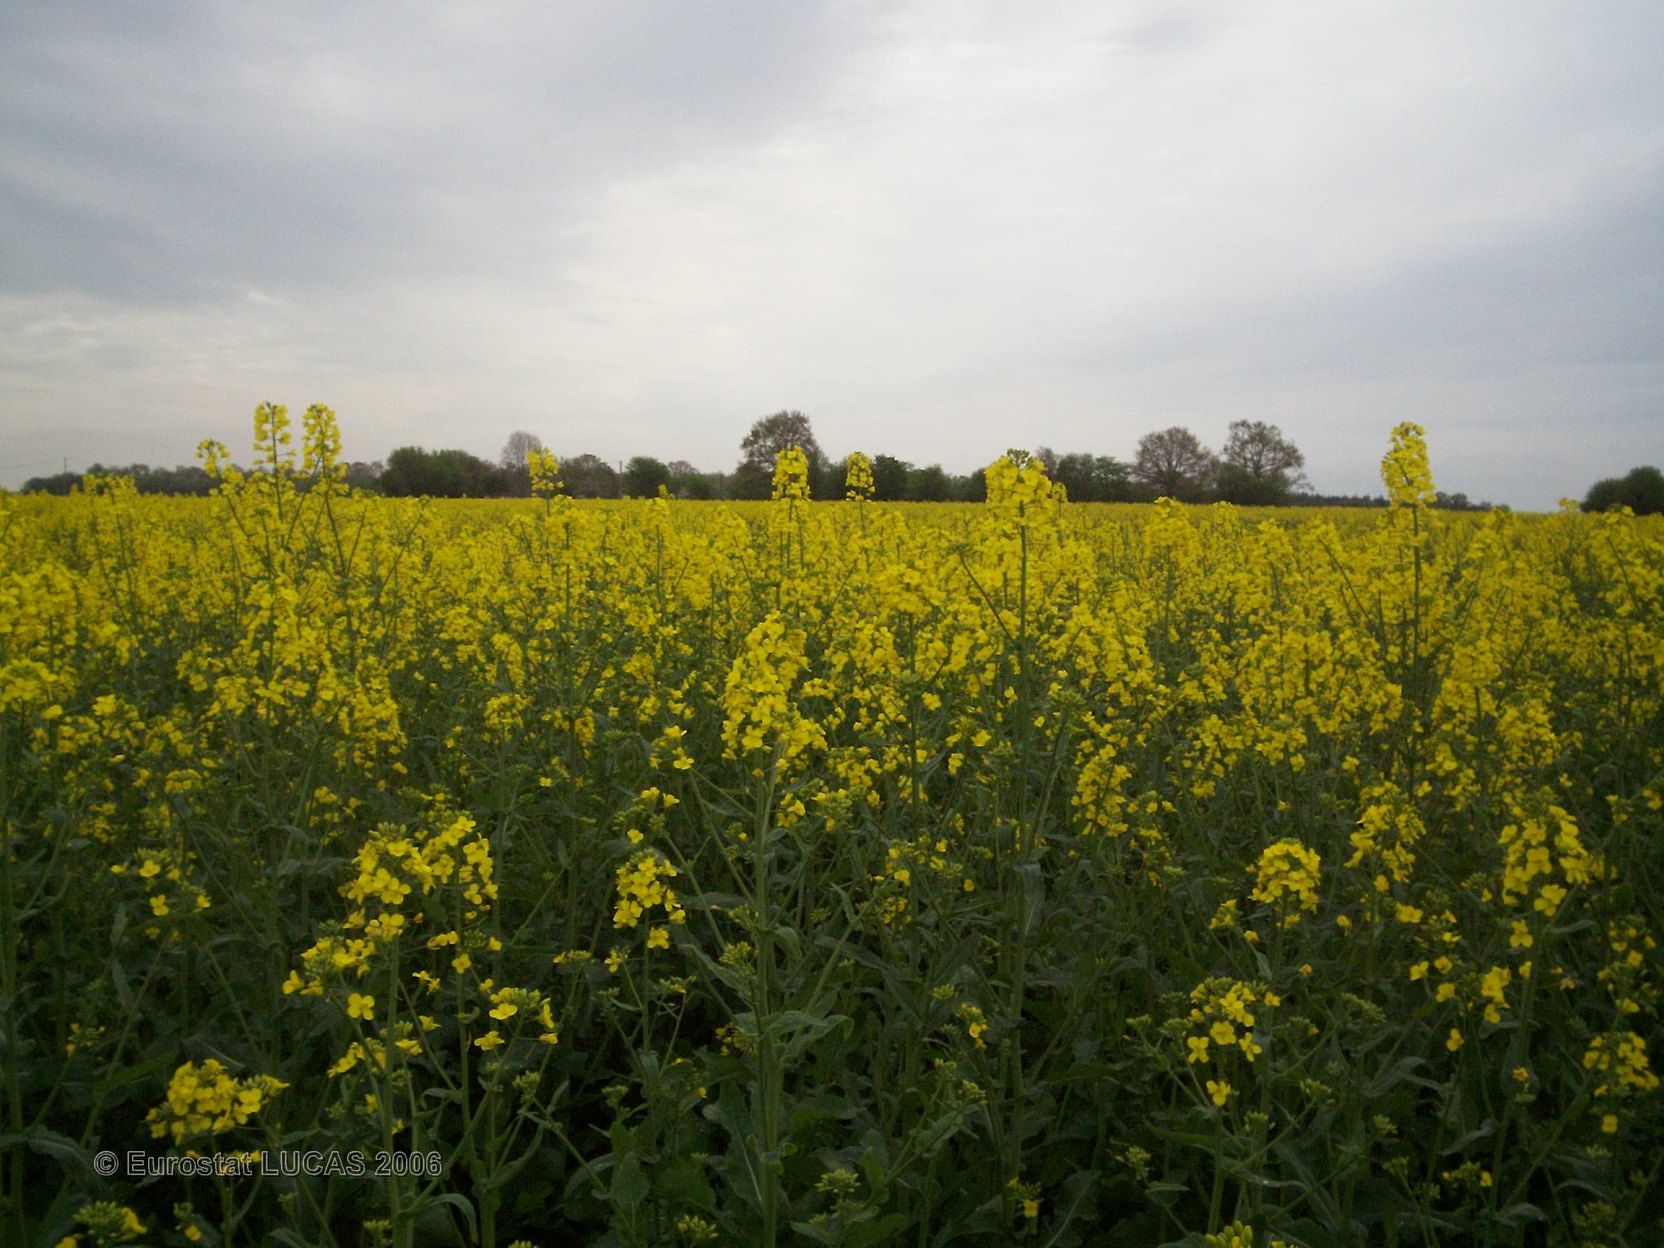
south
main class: Cropland
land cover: Rape and turnip rape
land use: Agriculture (excluding fallow land and kitchen gardens)
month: May
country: FR
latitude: 48.8724
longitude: 0.6088
